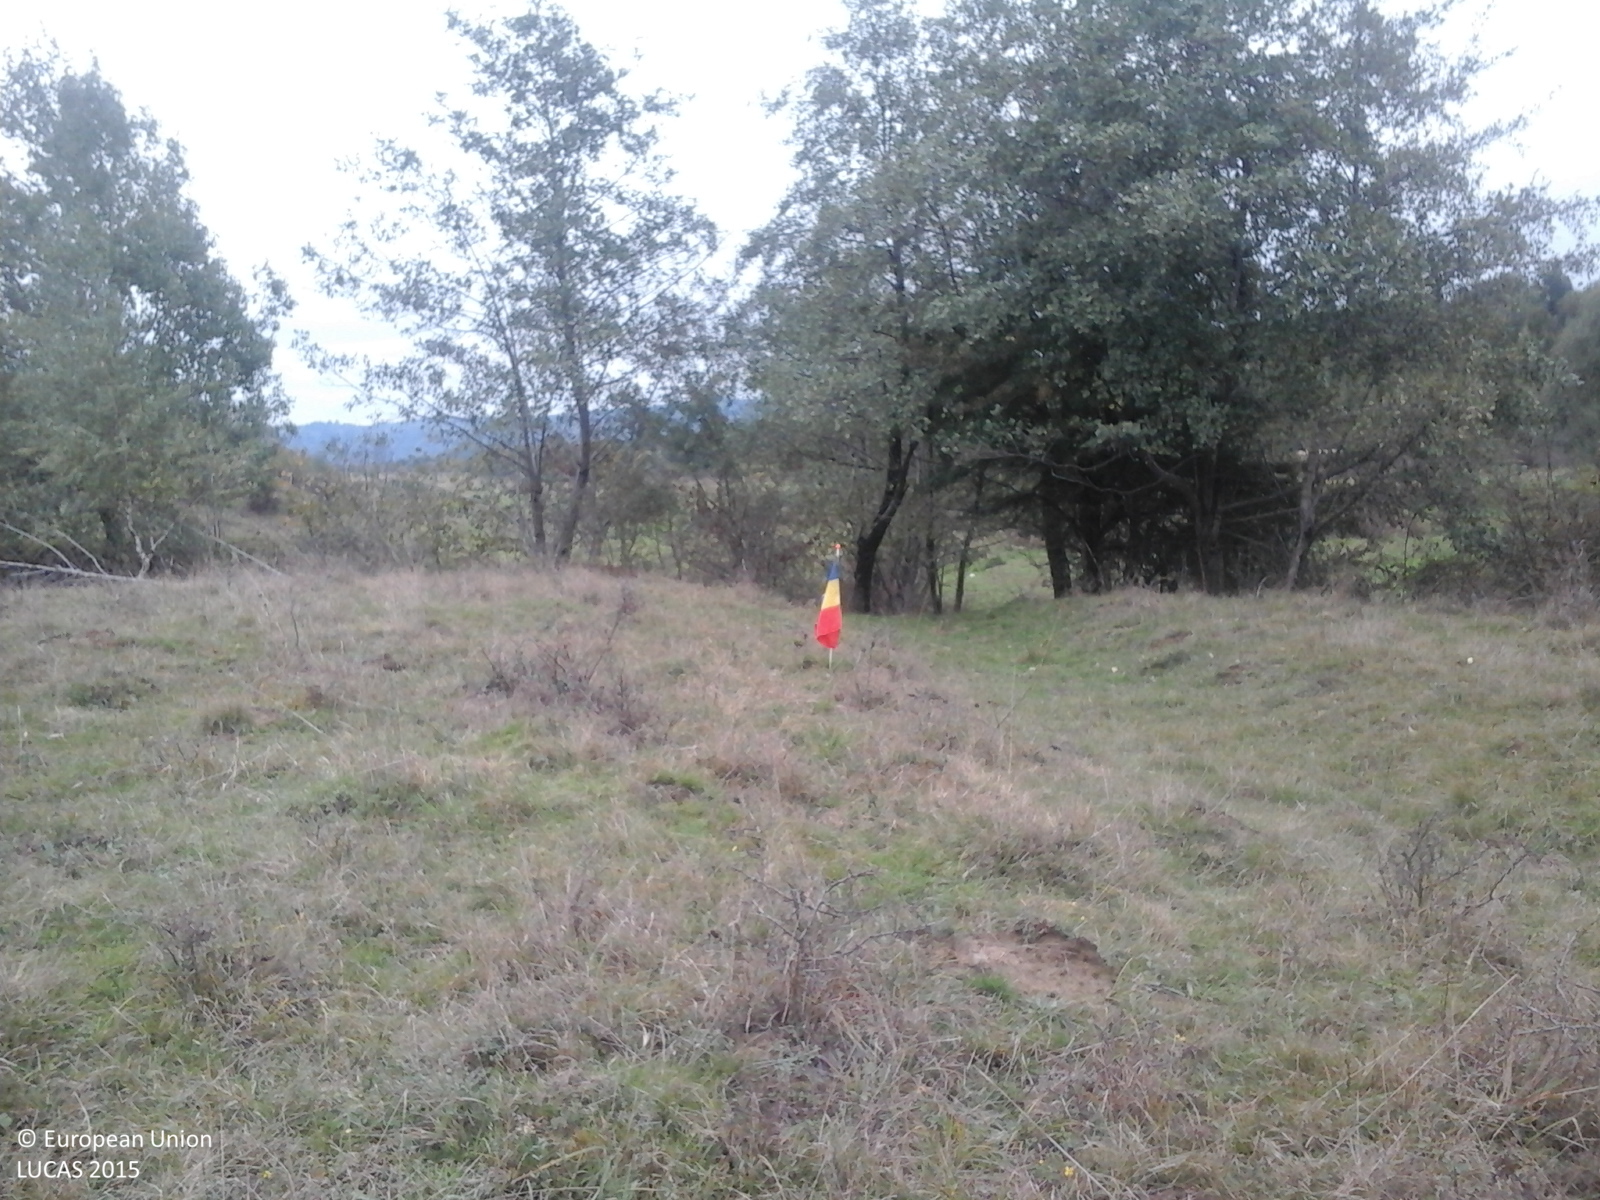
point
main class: Grassland
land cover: Grassland without tree/shrub cover
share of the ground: > 75 %
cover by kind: herbaceous plants 100 %
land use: Agriculture (excluding fallow land and kitchen gardens)
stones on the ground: < 10 %
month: October
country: RO
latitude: 45.7494
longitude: 24.7011
